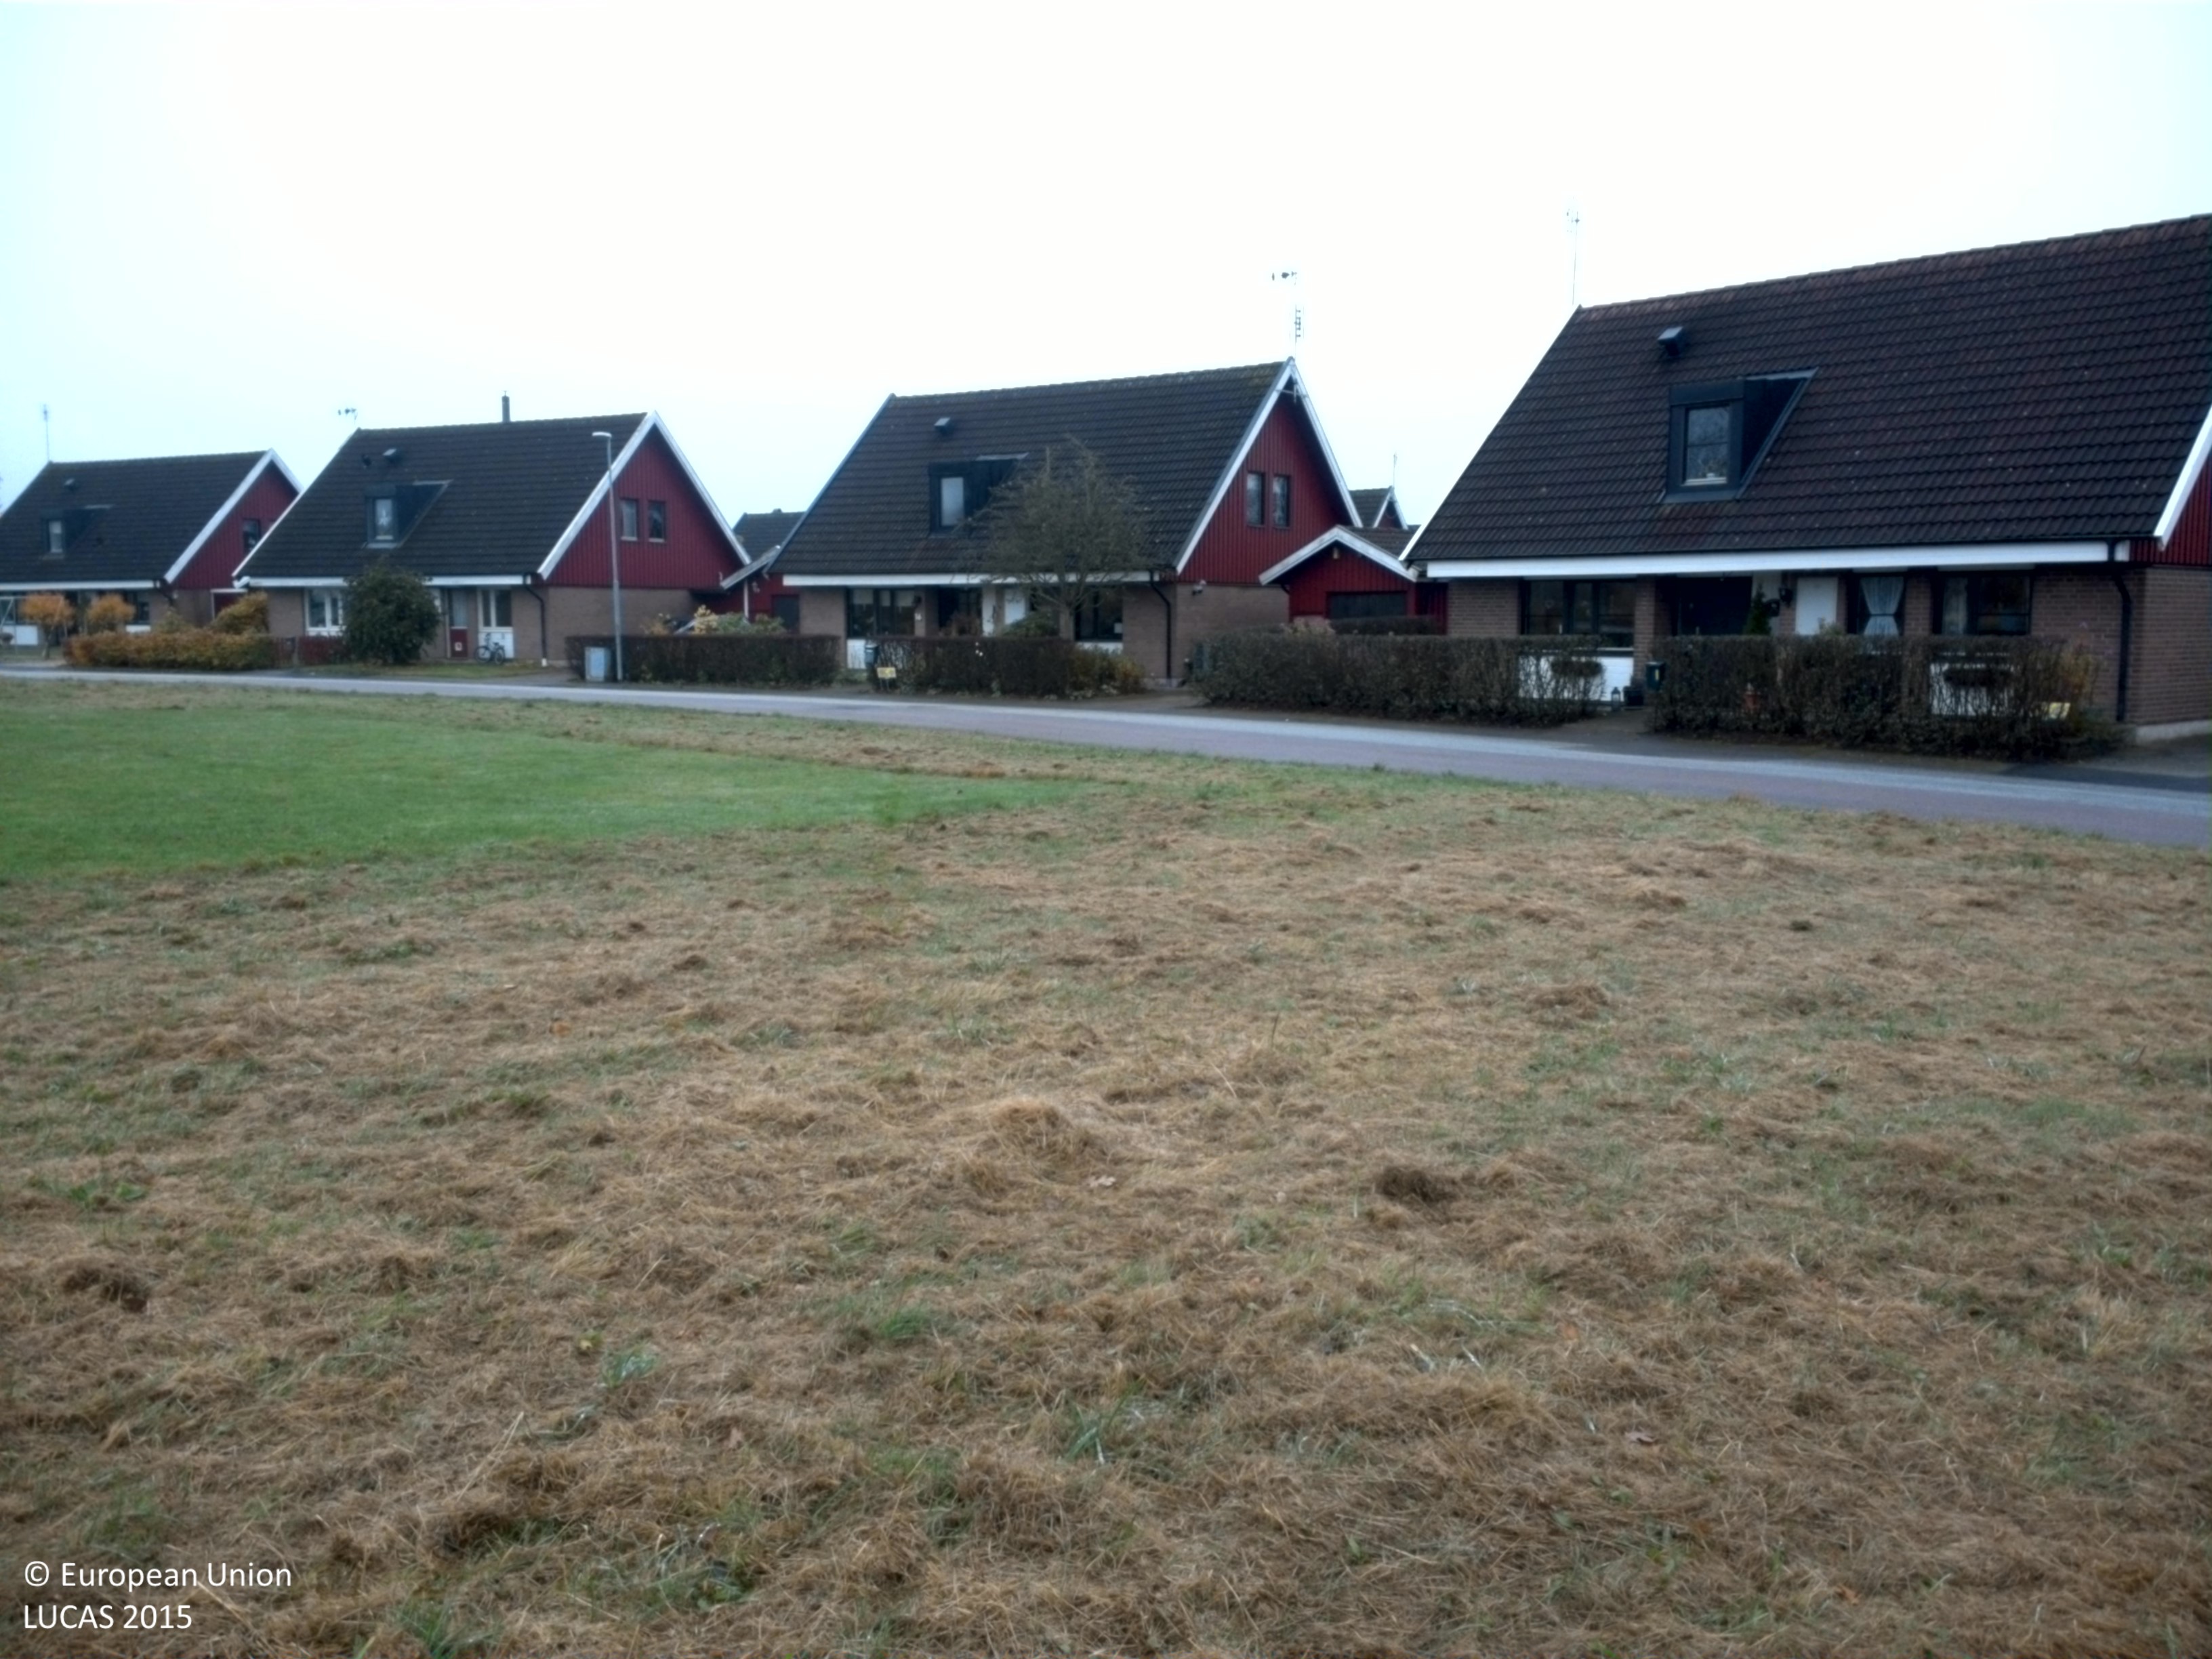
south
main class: Grassland
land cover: Grassland without tree/shrub cover
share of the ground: > 75 %
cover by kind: herbaceous plants 100 %
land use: Residential
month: November
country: SE
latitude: 56.0066
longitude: 13.0928
